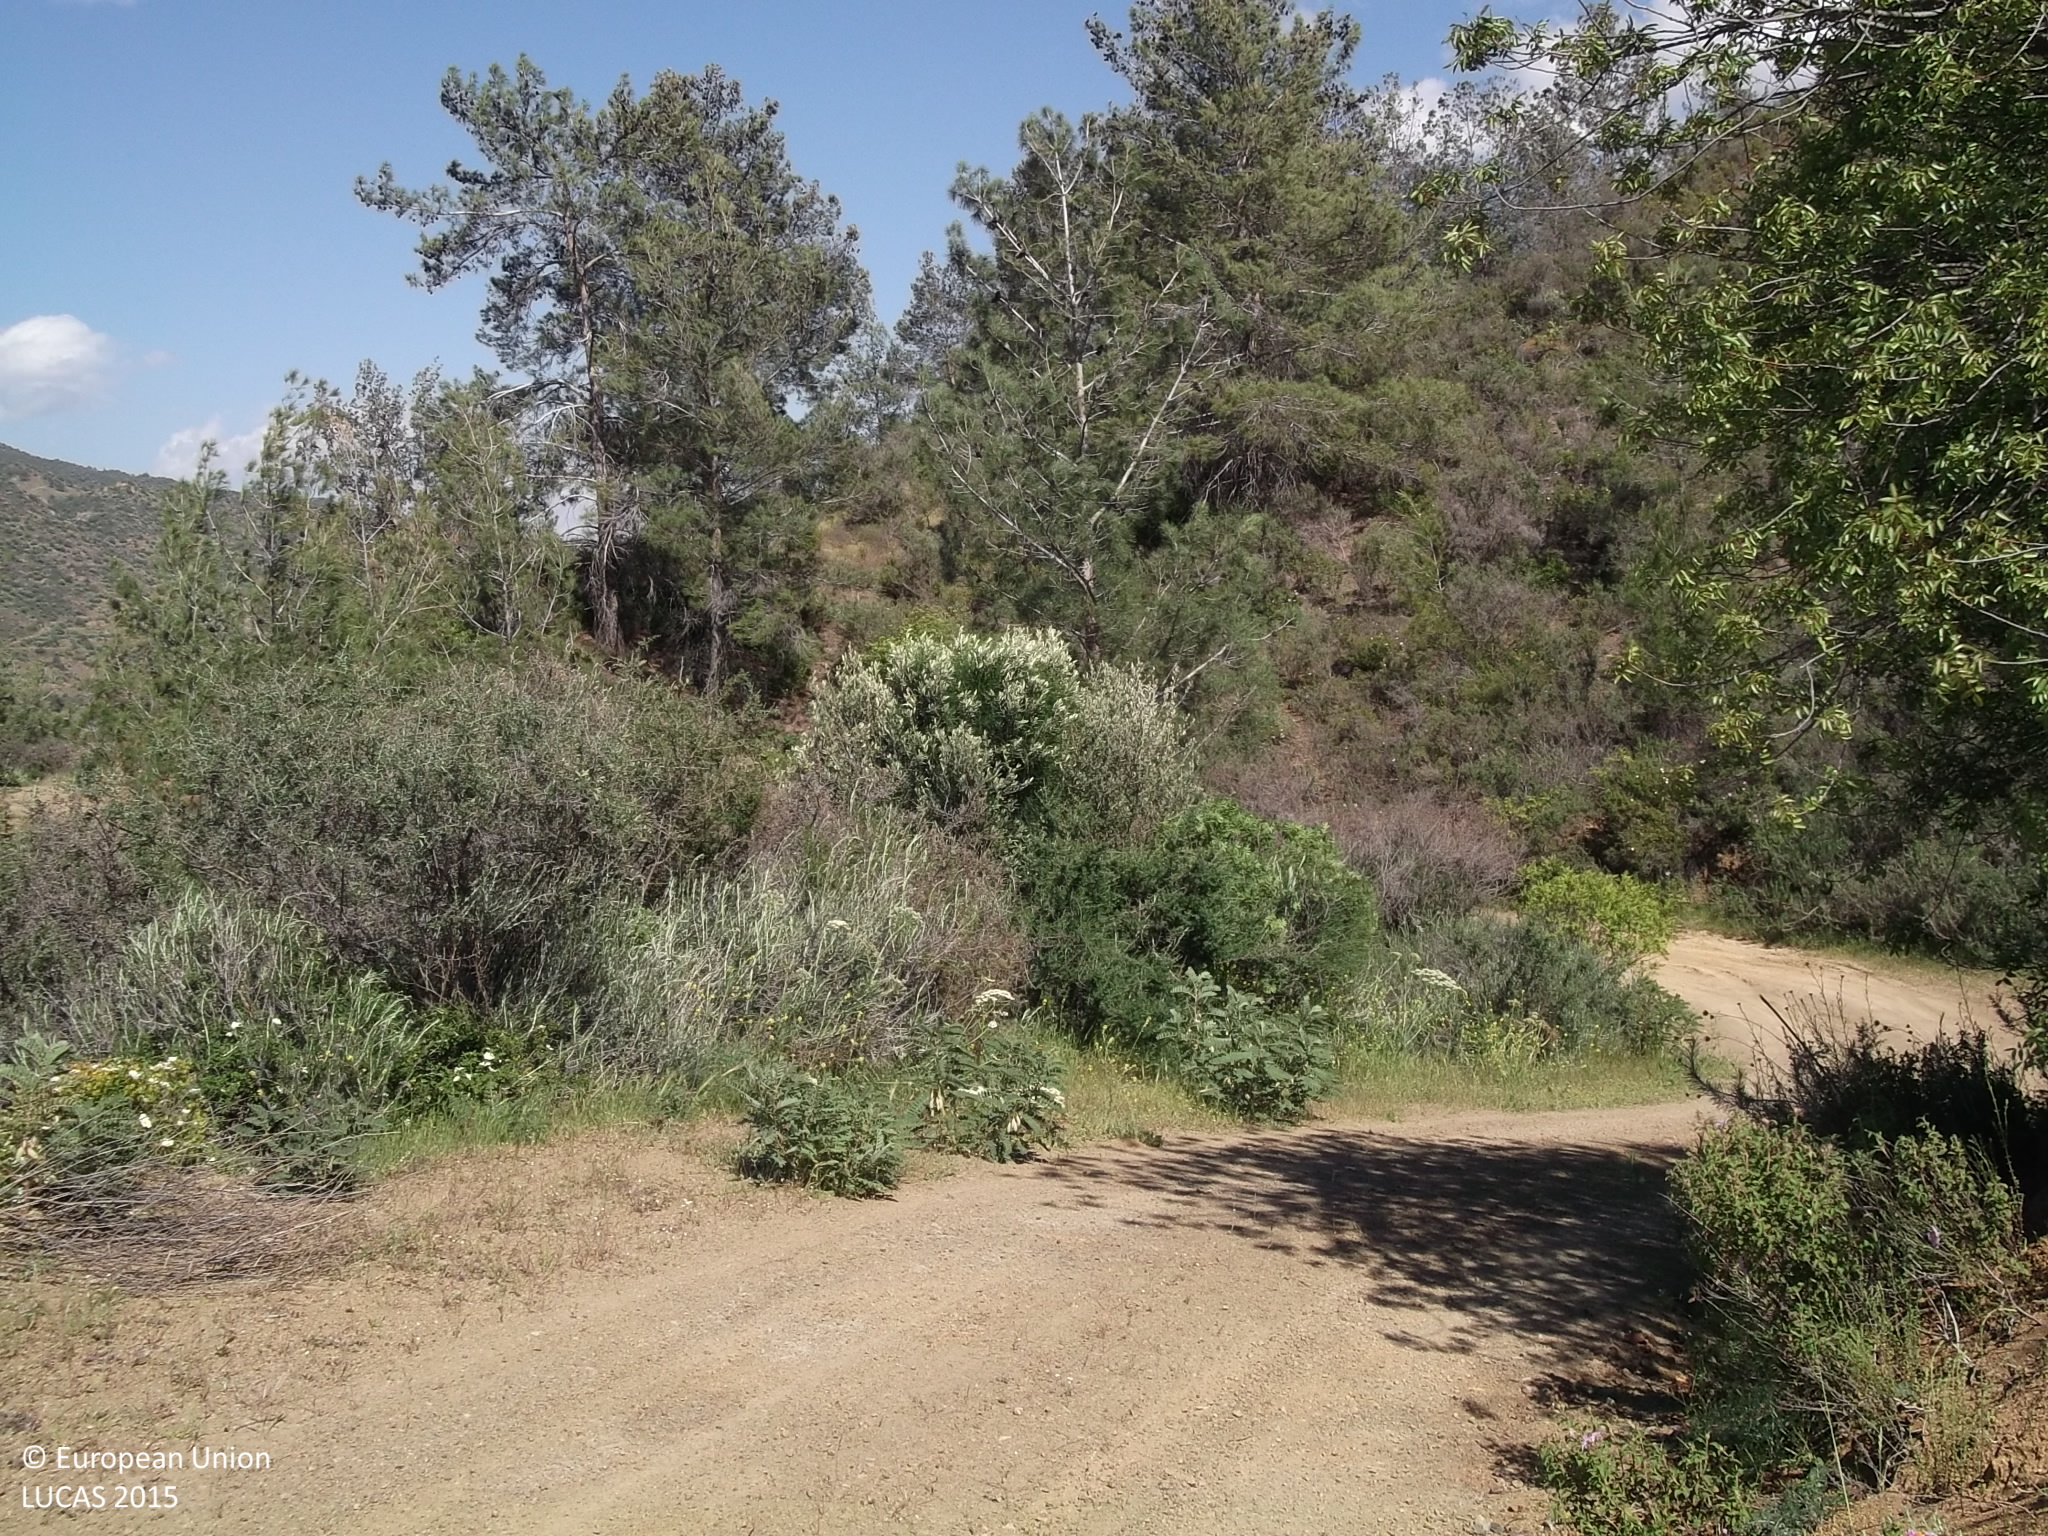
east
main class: Shrubland
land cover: Shrubland with sparse tree cover
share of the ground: > 75 %
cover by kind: shrubs 85 %, unconsolidated bare surface 10 %, coniferous forest trees 5 %
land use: Semi-natural and natural areas not in use
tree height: > 5 m
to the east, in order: Shrubland with sparse tree cover; Pine dominated coniferous woodland; Tracks; Shrubland without tree cover; Tracks; Shrubland without tree cover
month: April
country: CY
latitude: 34.8421
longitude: 33.1050
